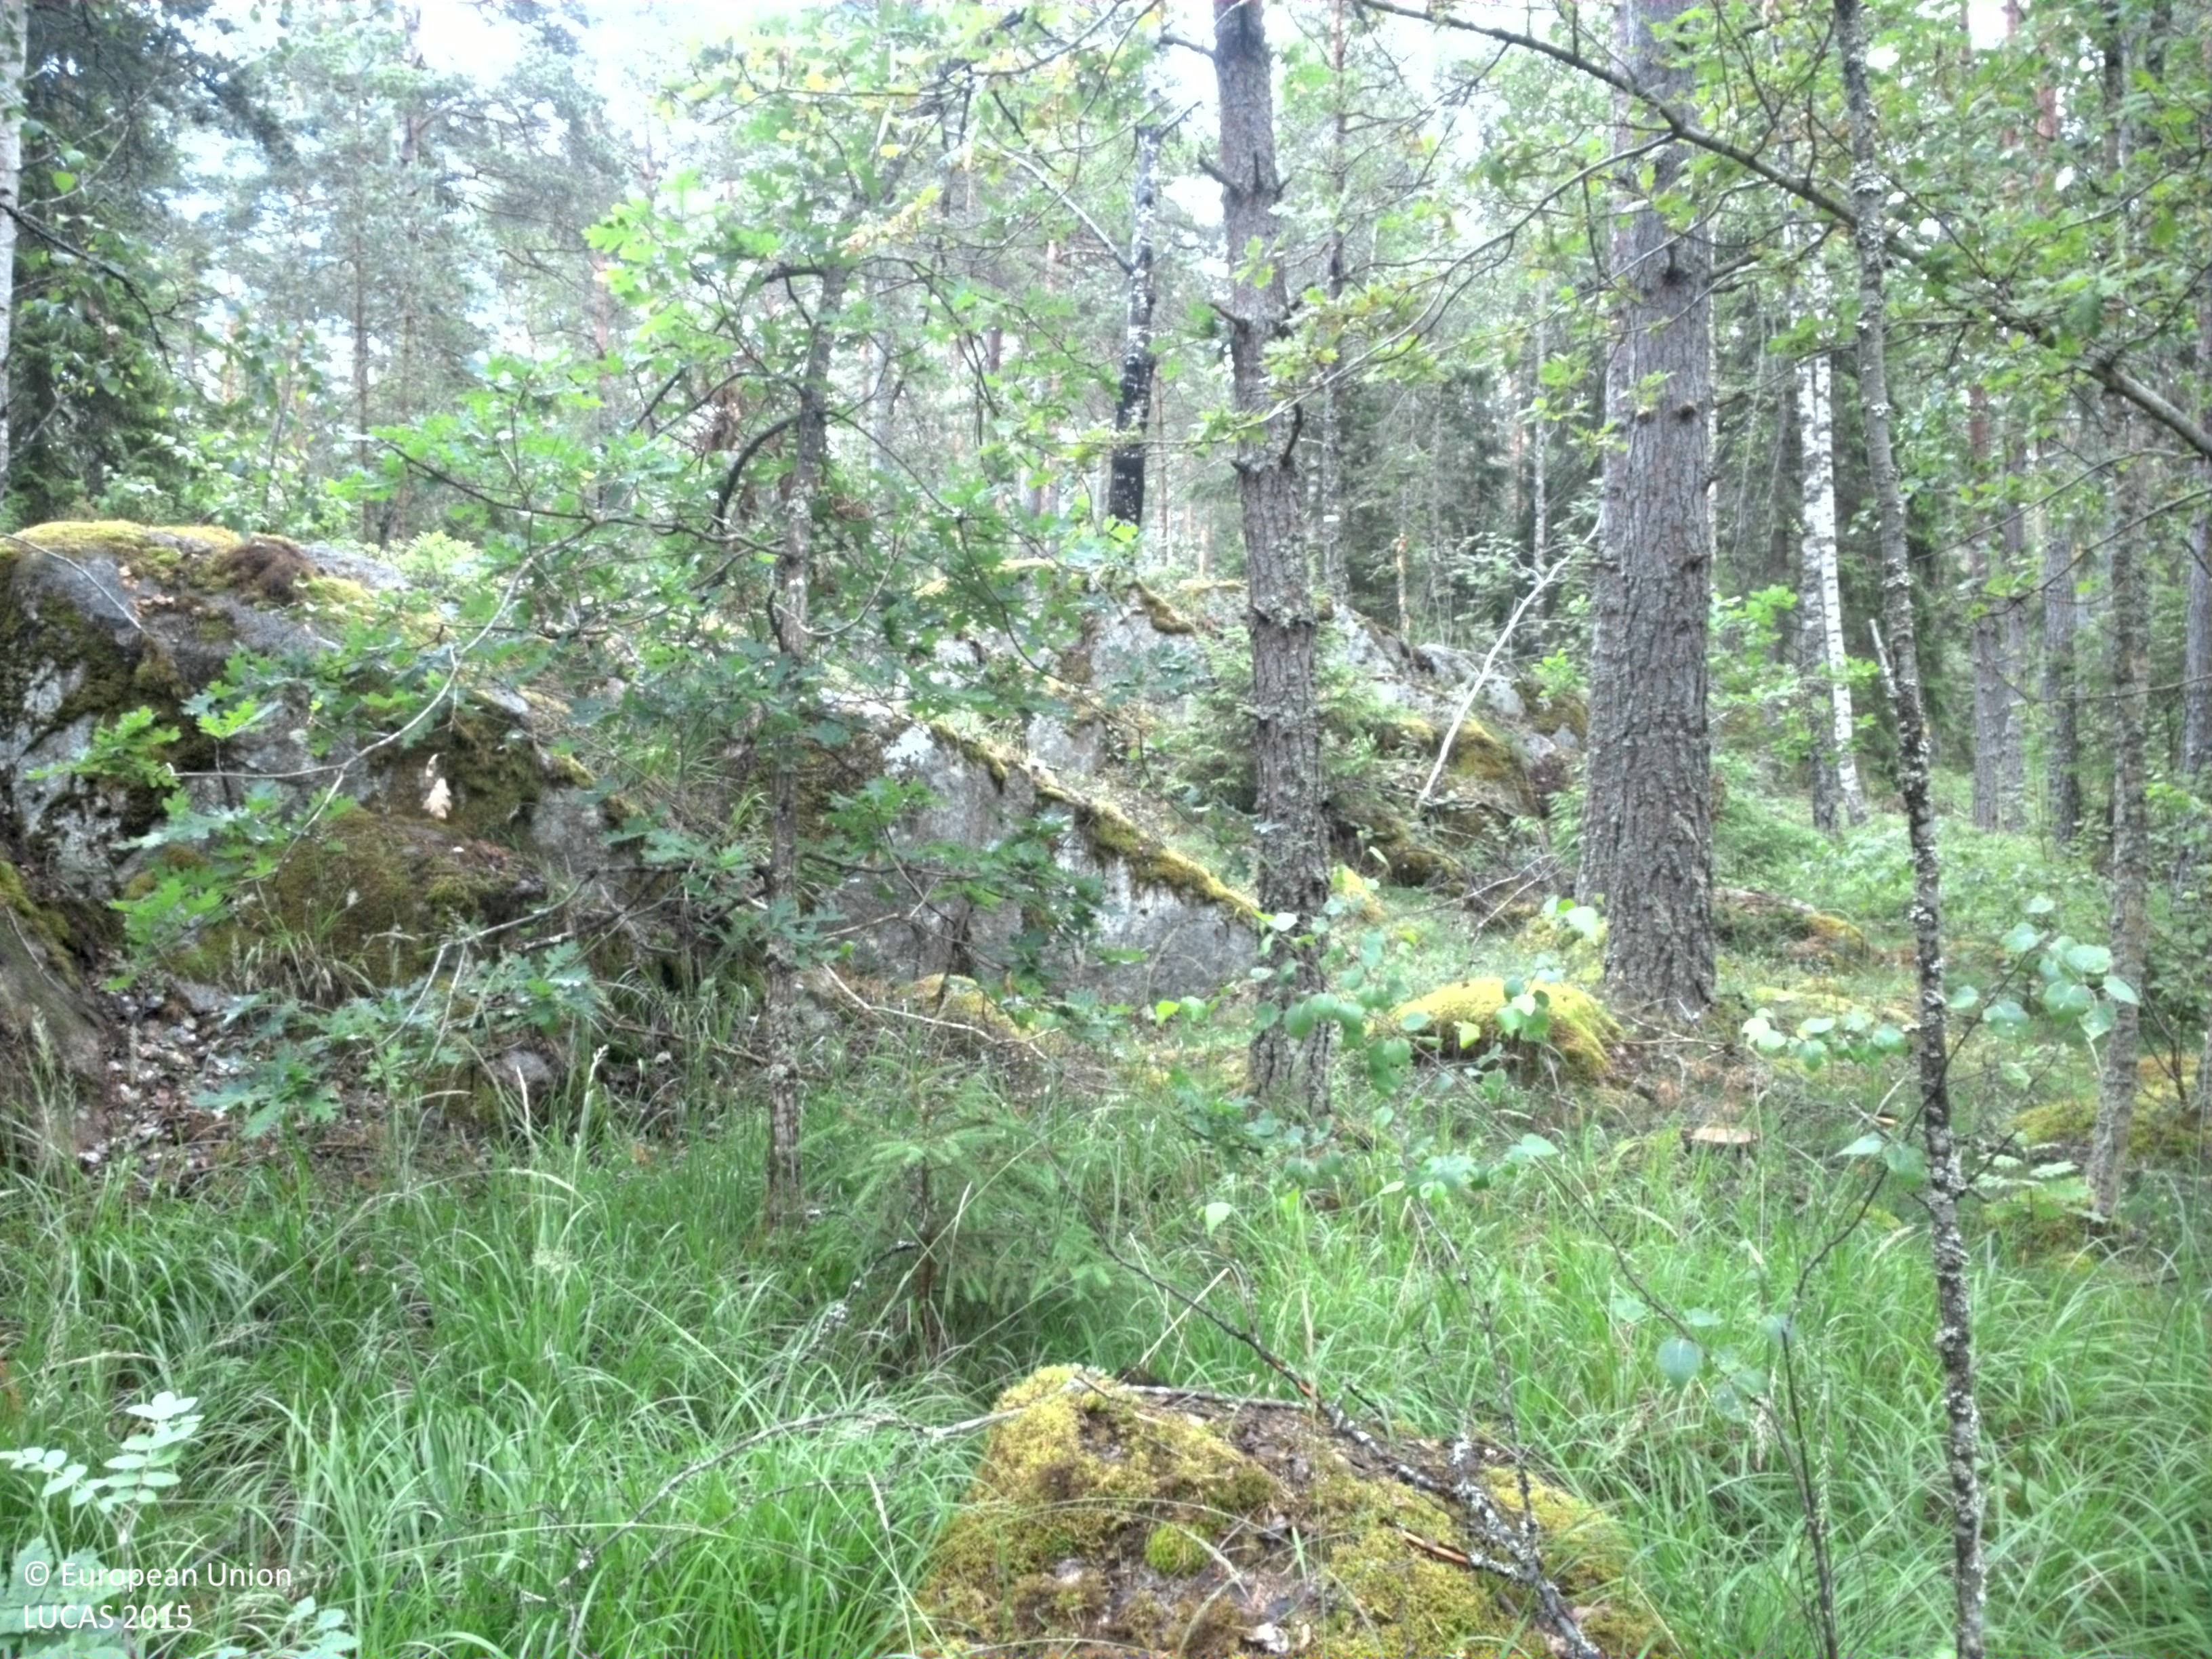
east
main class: Woodland
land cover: Pine dominated coniferous woodland
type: boreal forest
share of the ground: 50 - 75 %
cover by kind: coniferous forest trees 60 %, herbaceous plants 30 %, broadleaved forest trees 10 %
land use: Forestry
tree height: > 5 m
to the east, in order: Pine dominated coniferous woodland; Tracks; Pine dominated coniferous woodland; Other coniferous woodland
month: July
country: SE
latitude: 59.7906
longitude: 17.6743
